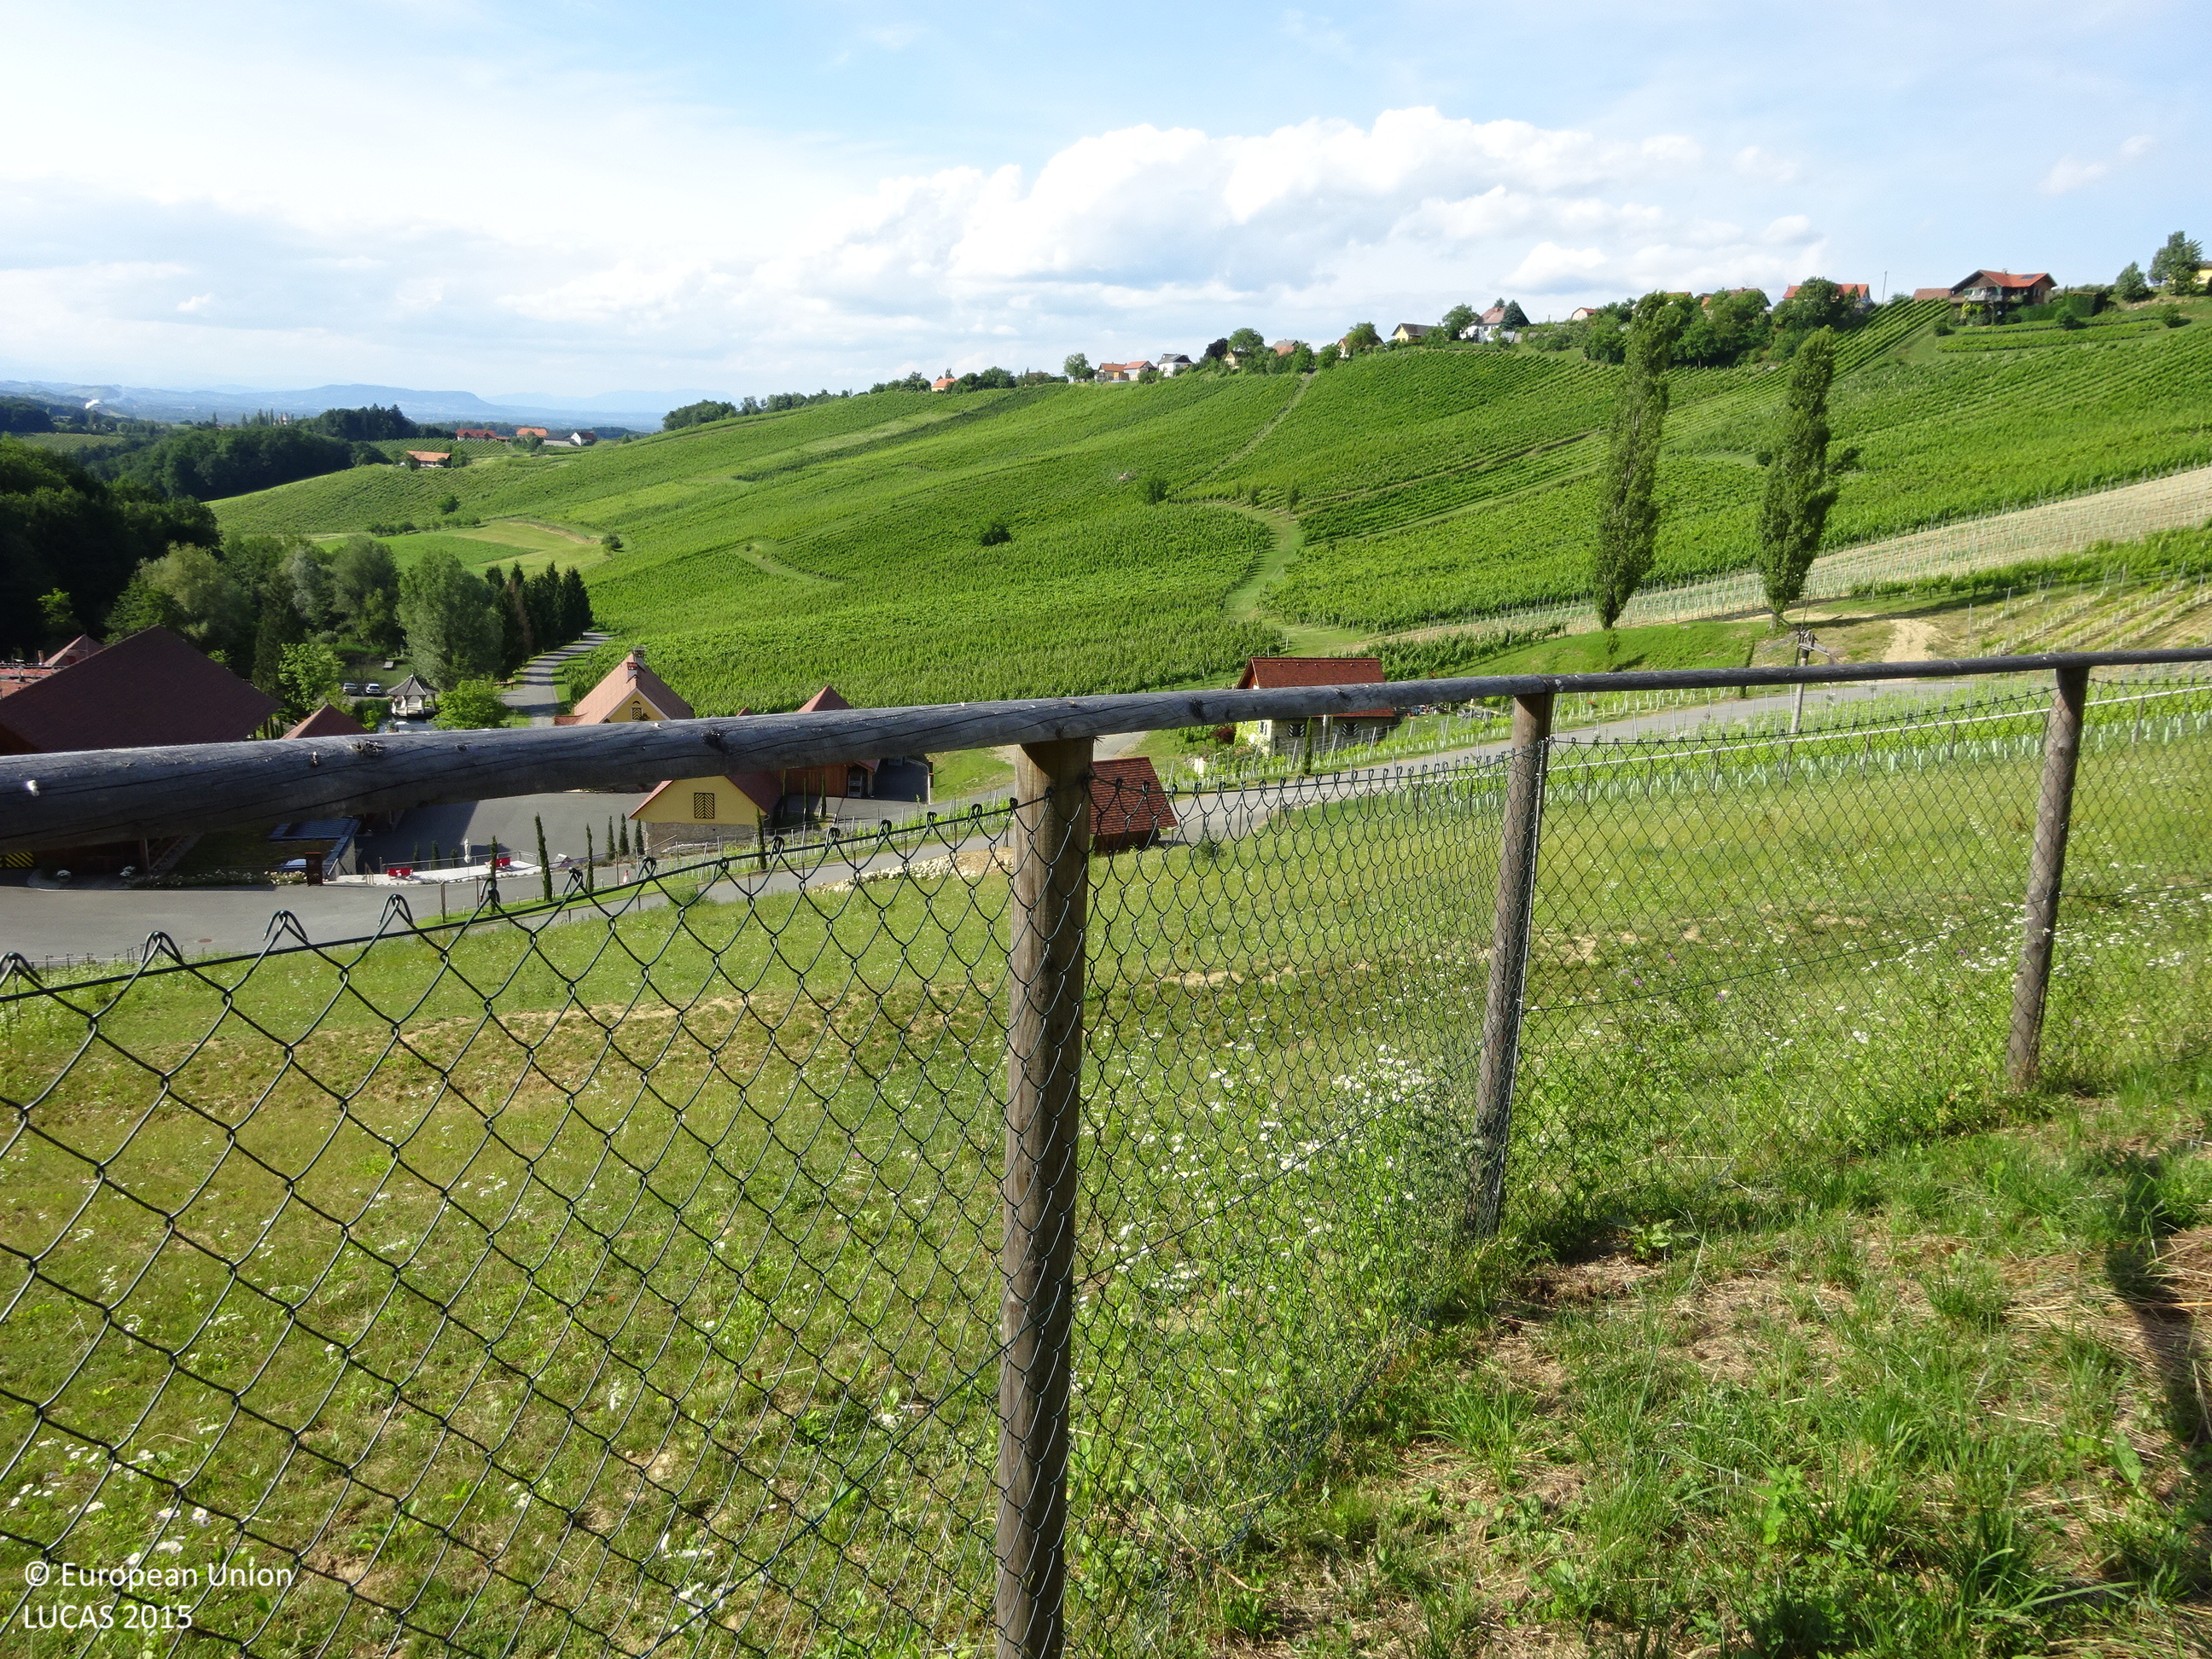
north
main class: Grassland
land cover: Grassland without tree/shrub cover
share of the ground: > 75 %
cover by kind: herbaceous plants 100 %
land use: Agriculture (excluding fallow land and kitchen gardens)
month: June
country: AT
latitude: 46.6914
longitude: 15.6090
